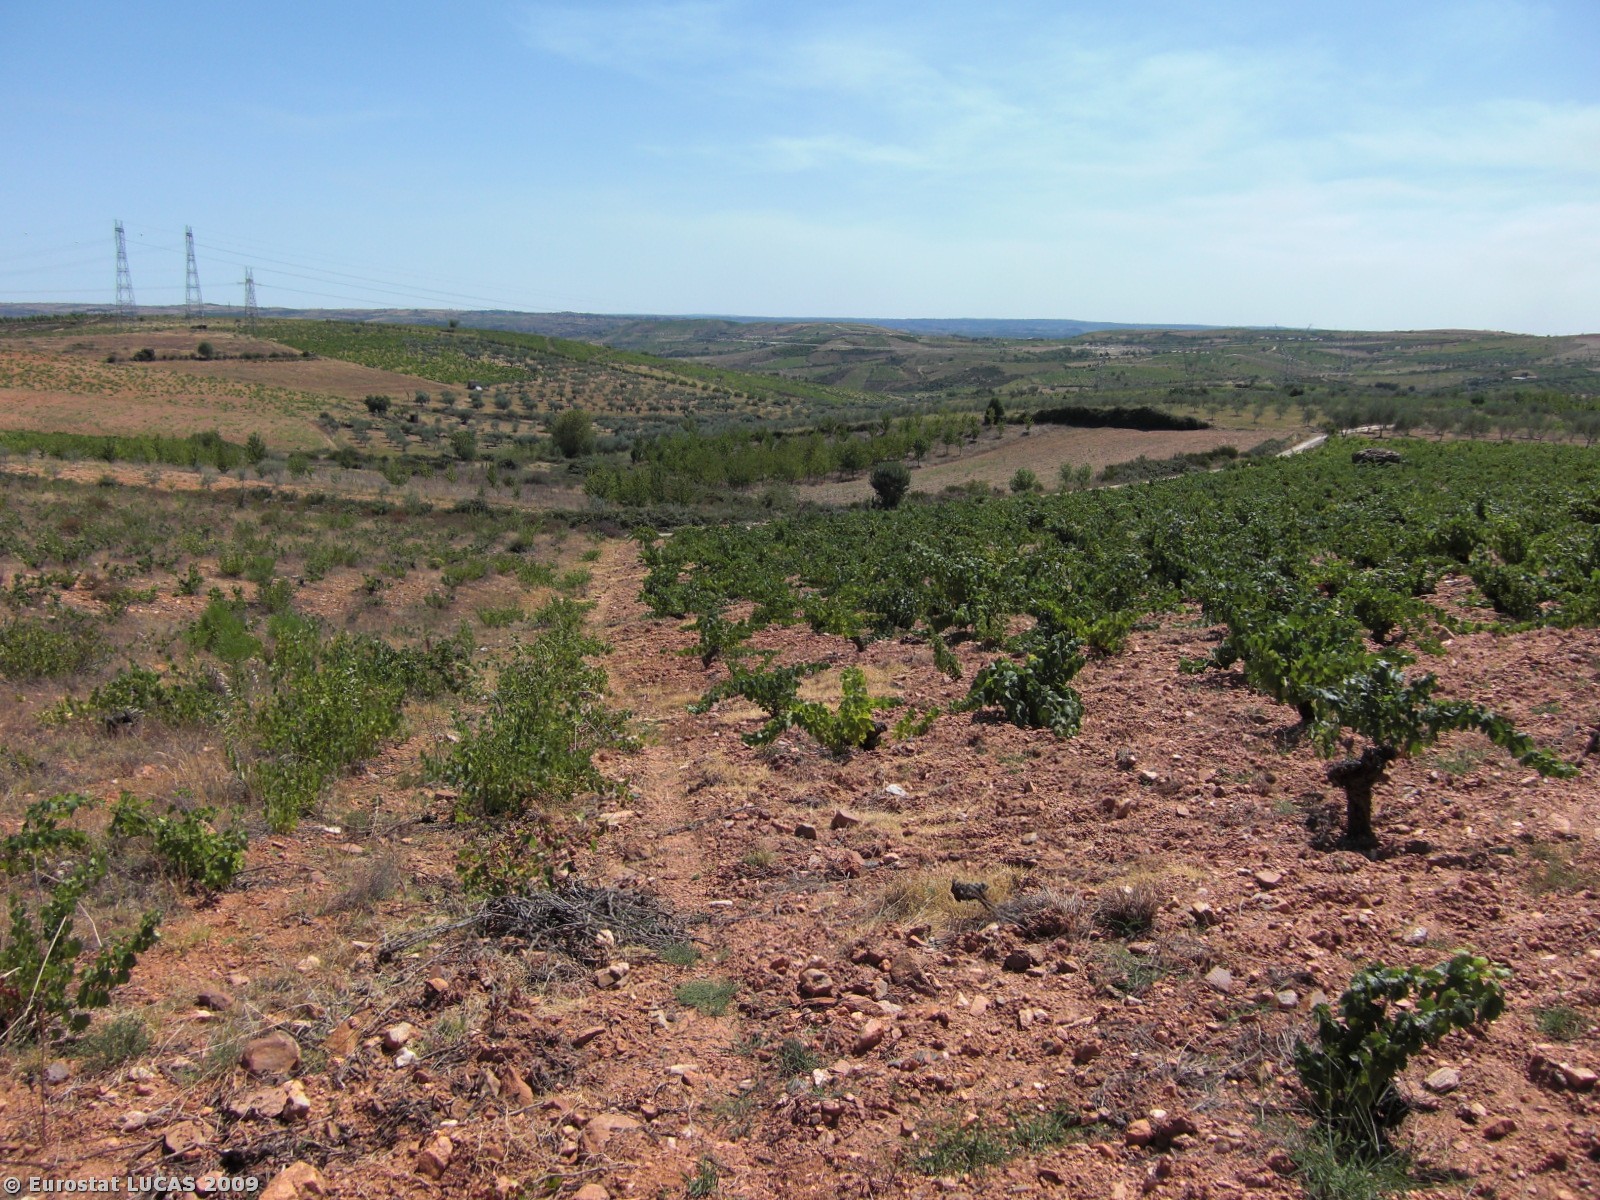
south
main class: Cropland
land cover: Vineyards
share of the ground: 10 - 25 %
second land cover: Spontaneously vegetated surfaces
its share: 50 - 75 %
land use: Agriculture (excluding fallow land and kitchen gardens)
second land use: Fallow land
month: August
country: PT
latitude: 41.3983
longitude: -6.4015
